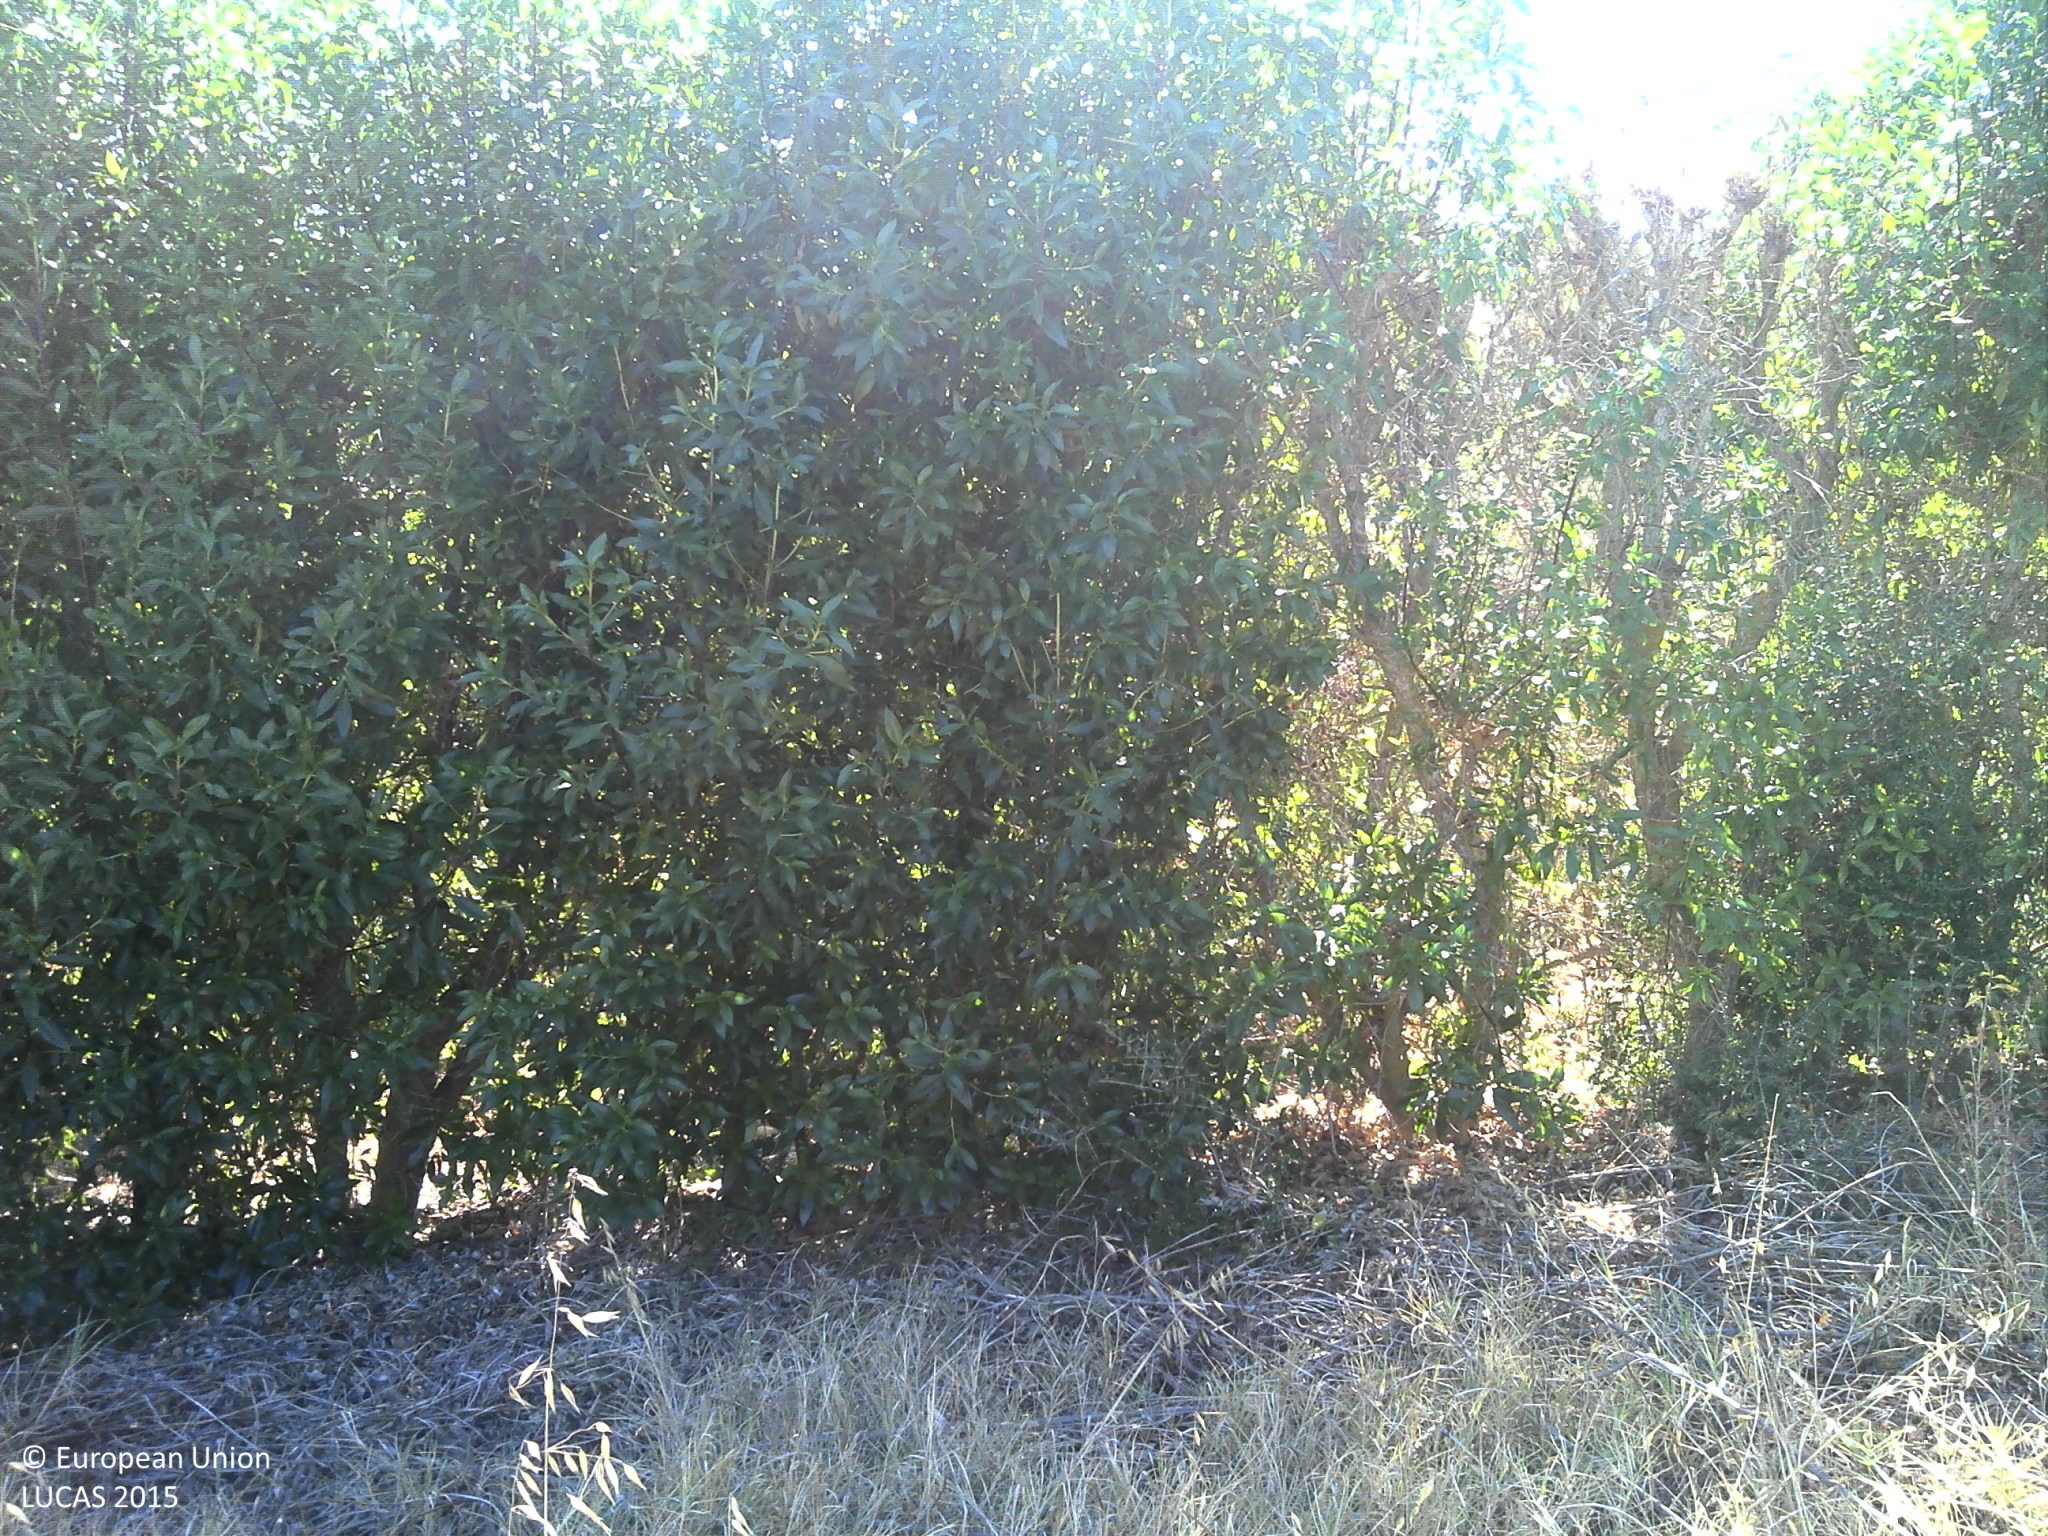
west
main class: Cropland
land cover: Nuts trees
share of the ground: 25 - 50 %
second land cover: Grassland without tree/shrub cover
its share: 25 - 50 %
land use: Agriculture (excluding fallow land and kitchen gardens)
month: July
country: PT
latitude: 37.0908
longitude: -8.7388
